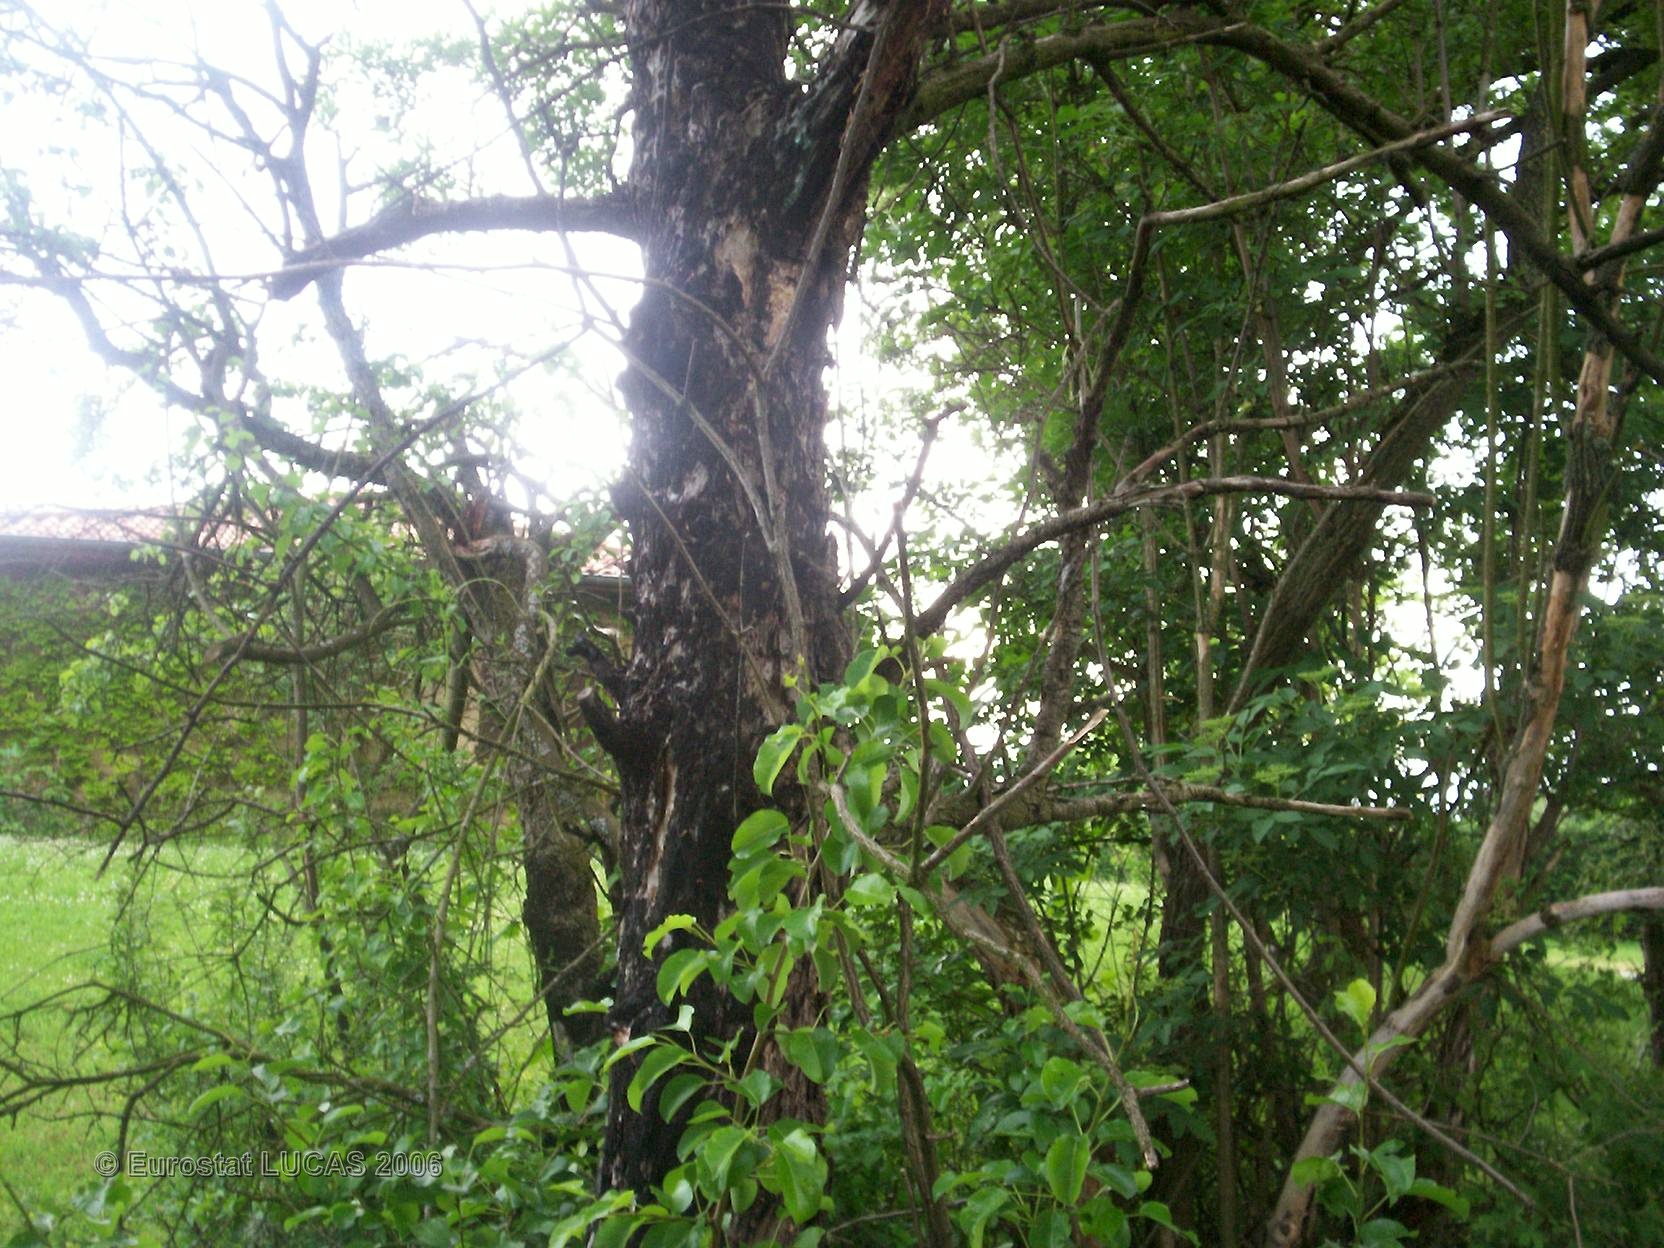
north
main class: Grassland
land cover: Grassland with sparse tree/shrub cover
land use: Residential
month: May
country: FR
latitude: 45.8067
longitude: 4.7404
